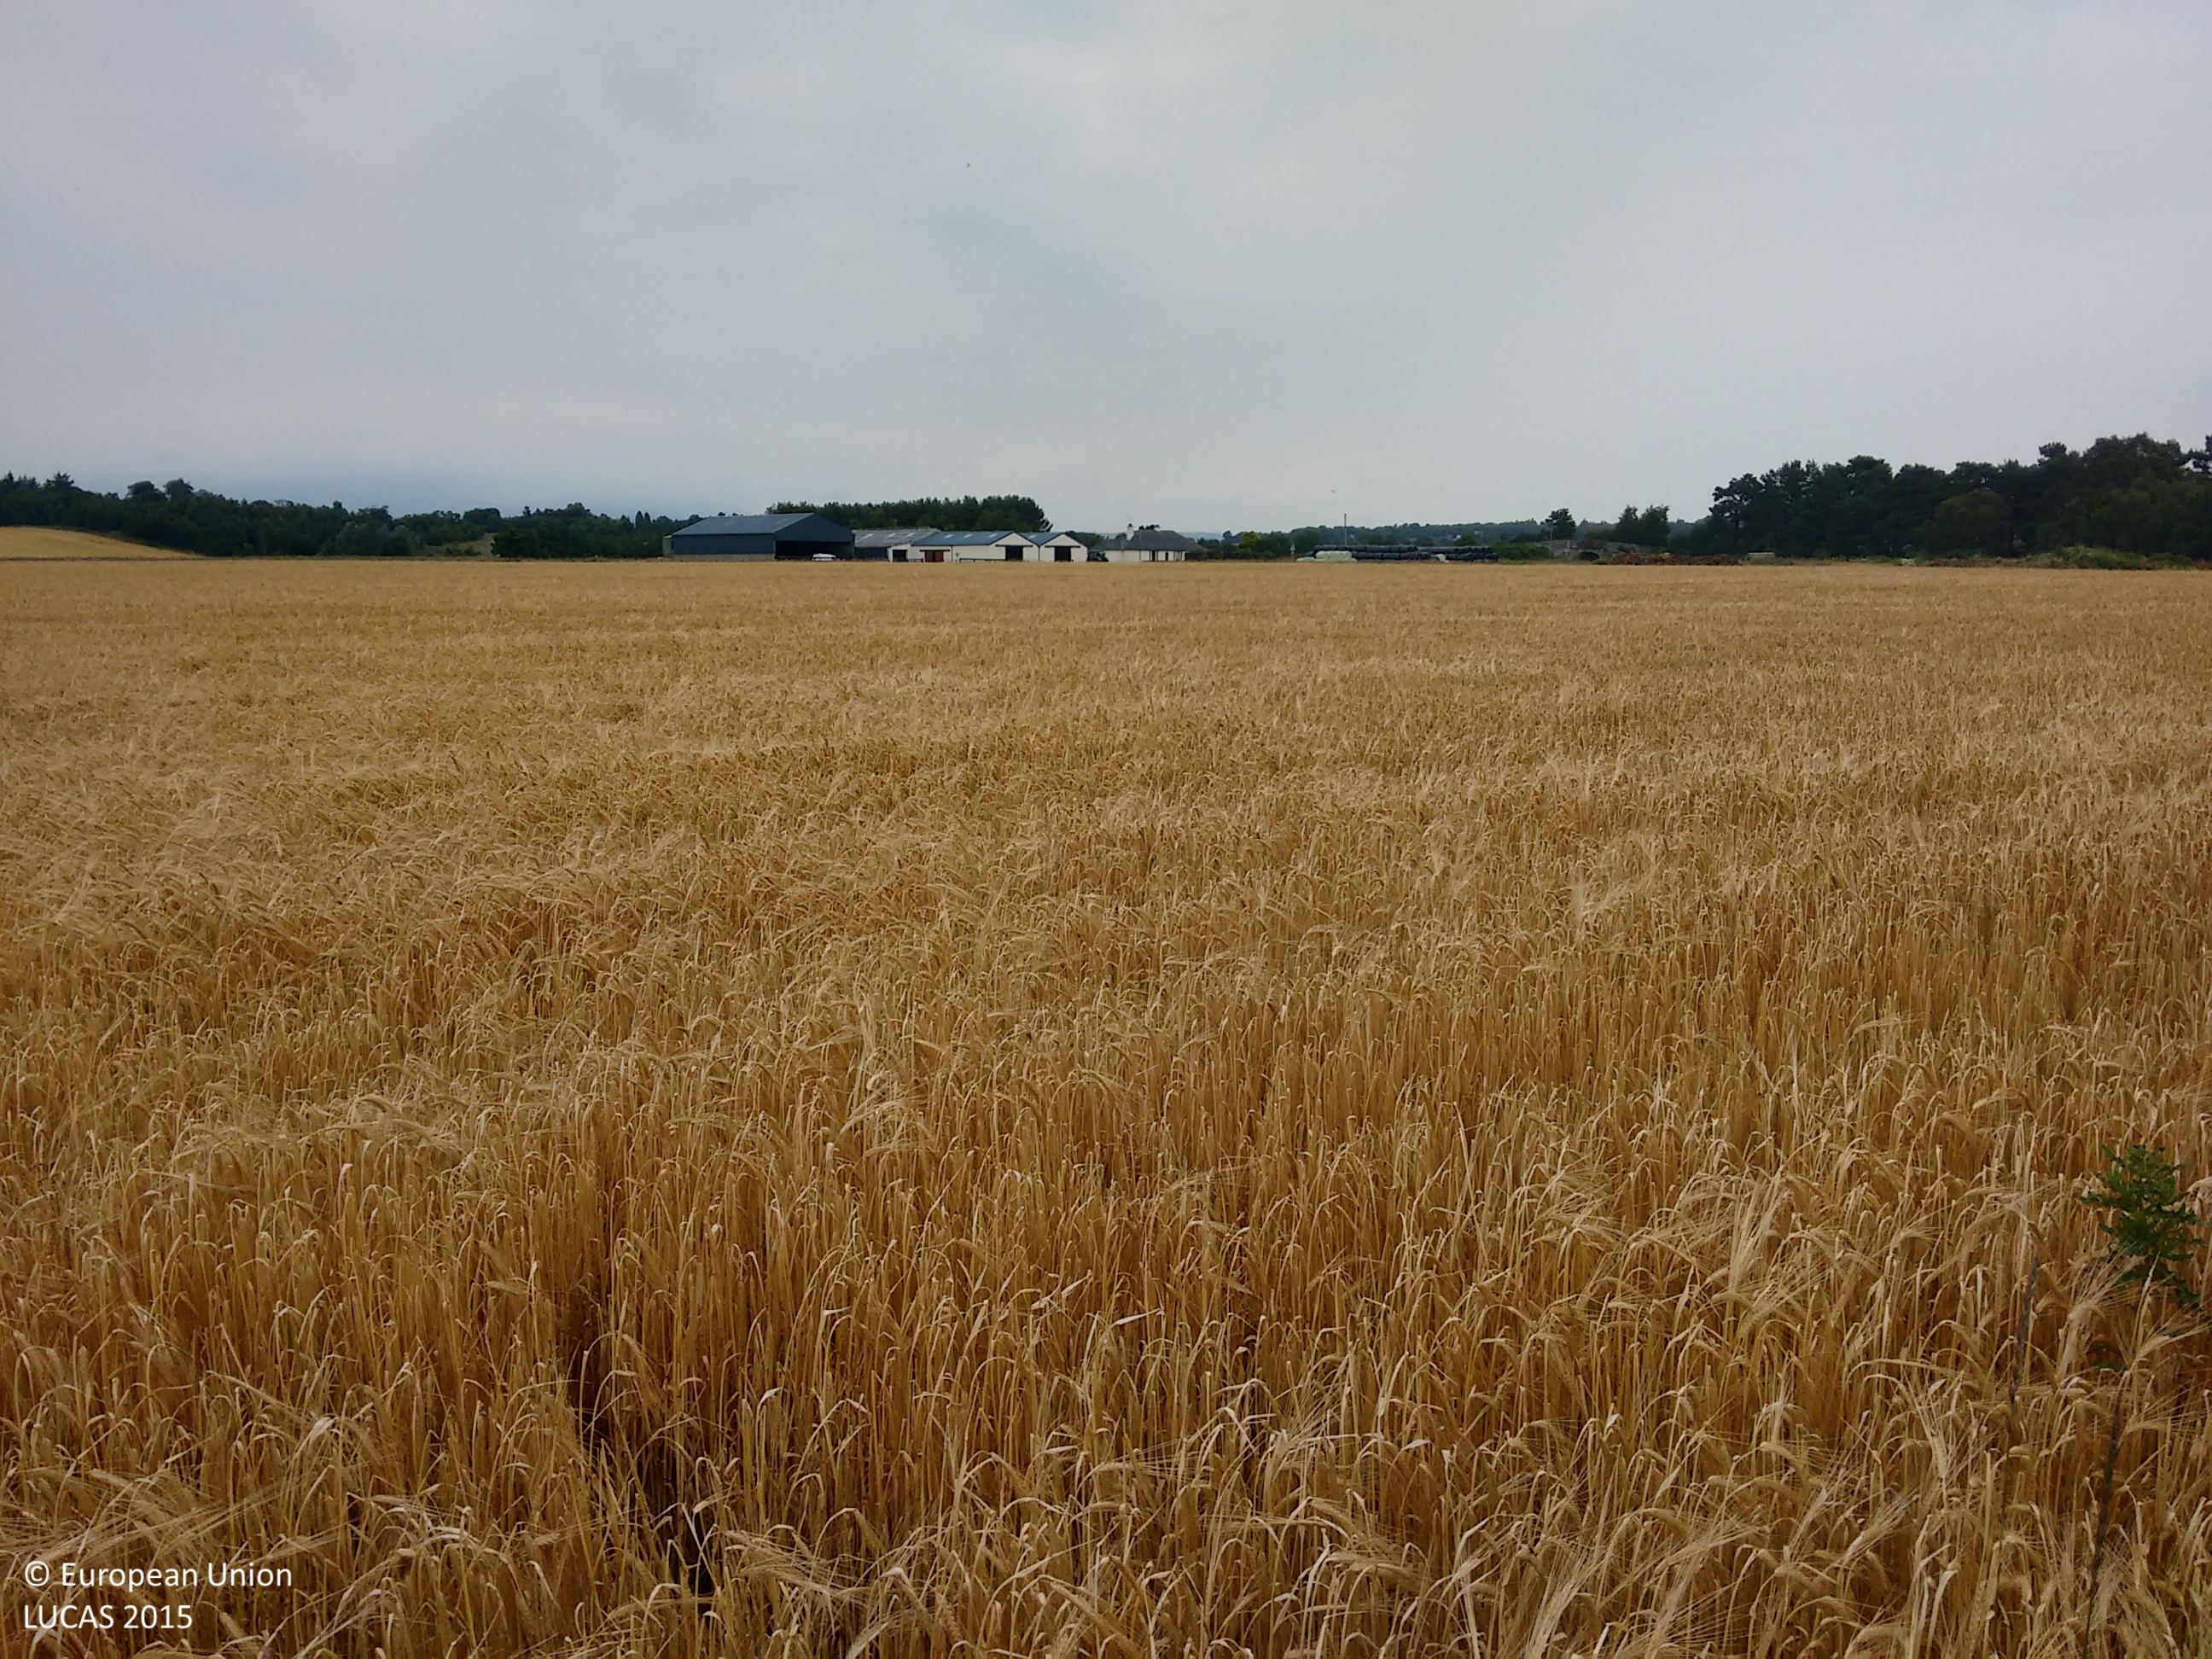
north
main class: Cropland
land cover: Barley
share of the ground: > 75 %
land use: Agriculture (excluding fallow land and kitchen gardens)
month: August
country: GB
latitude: 57.5048
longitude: -4.4597
